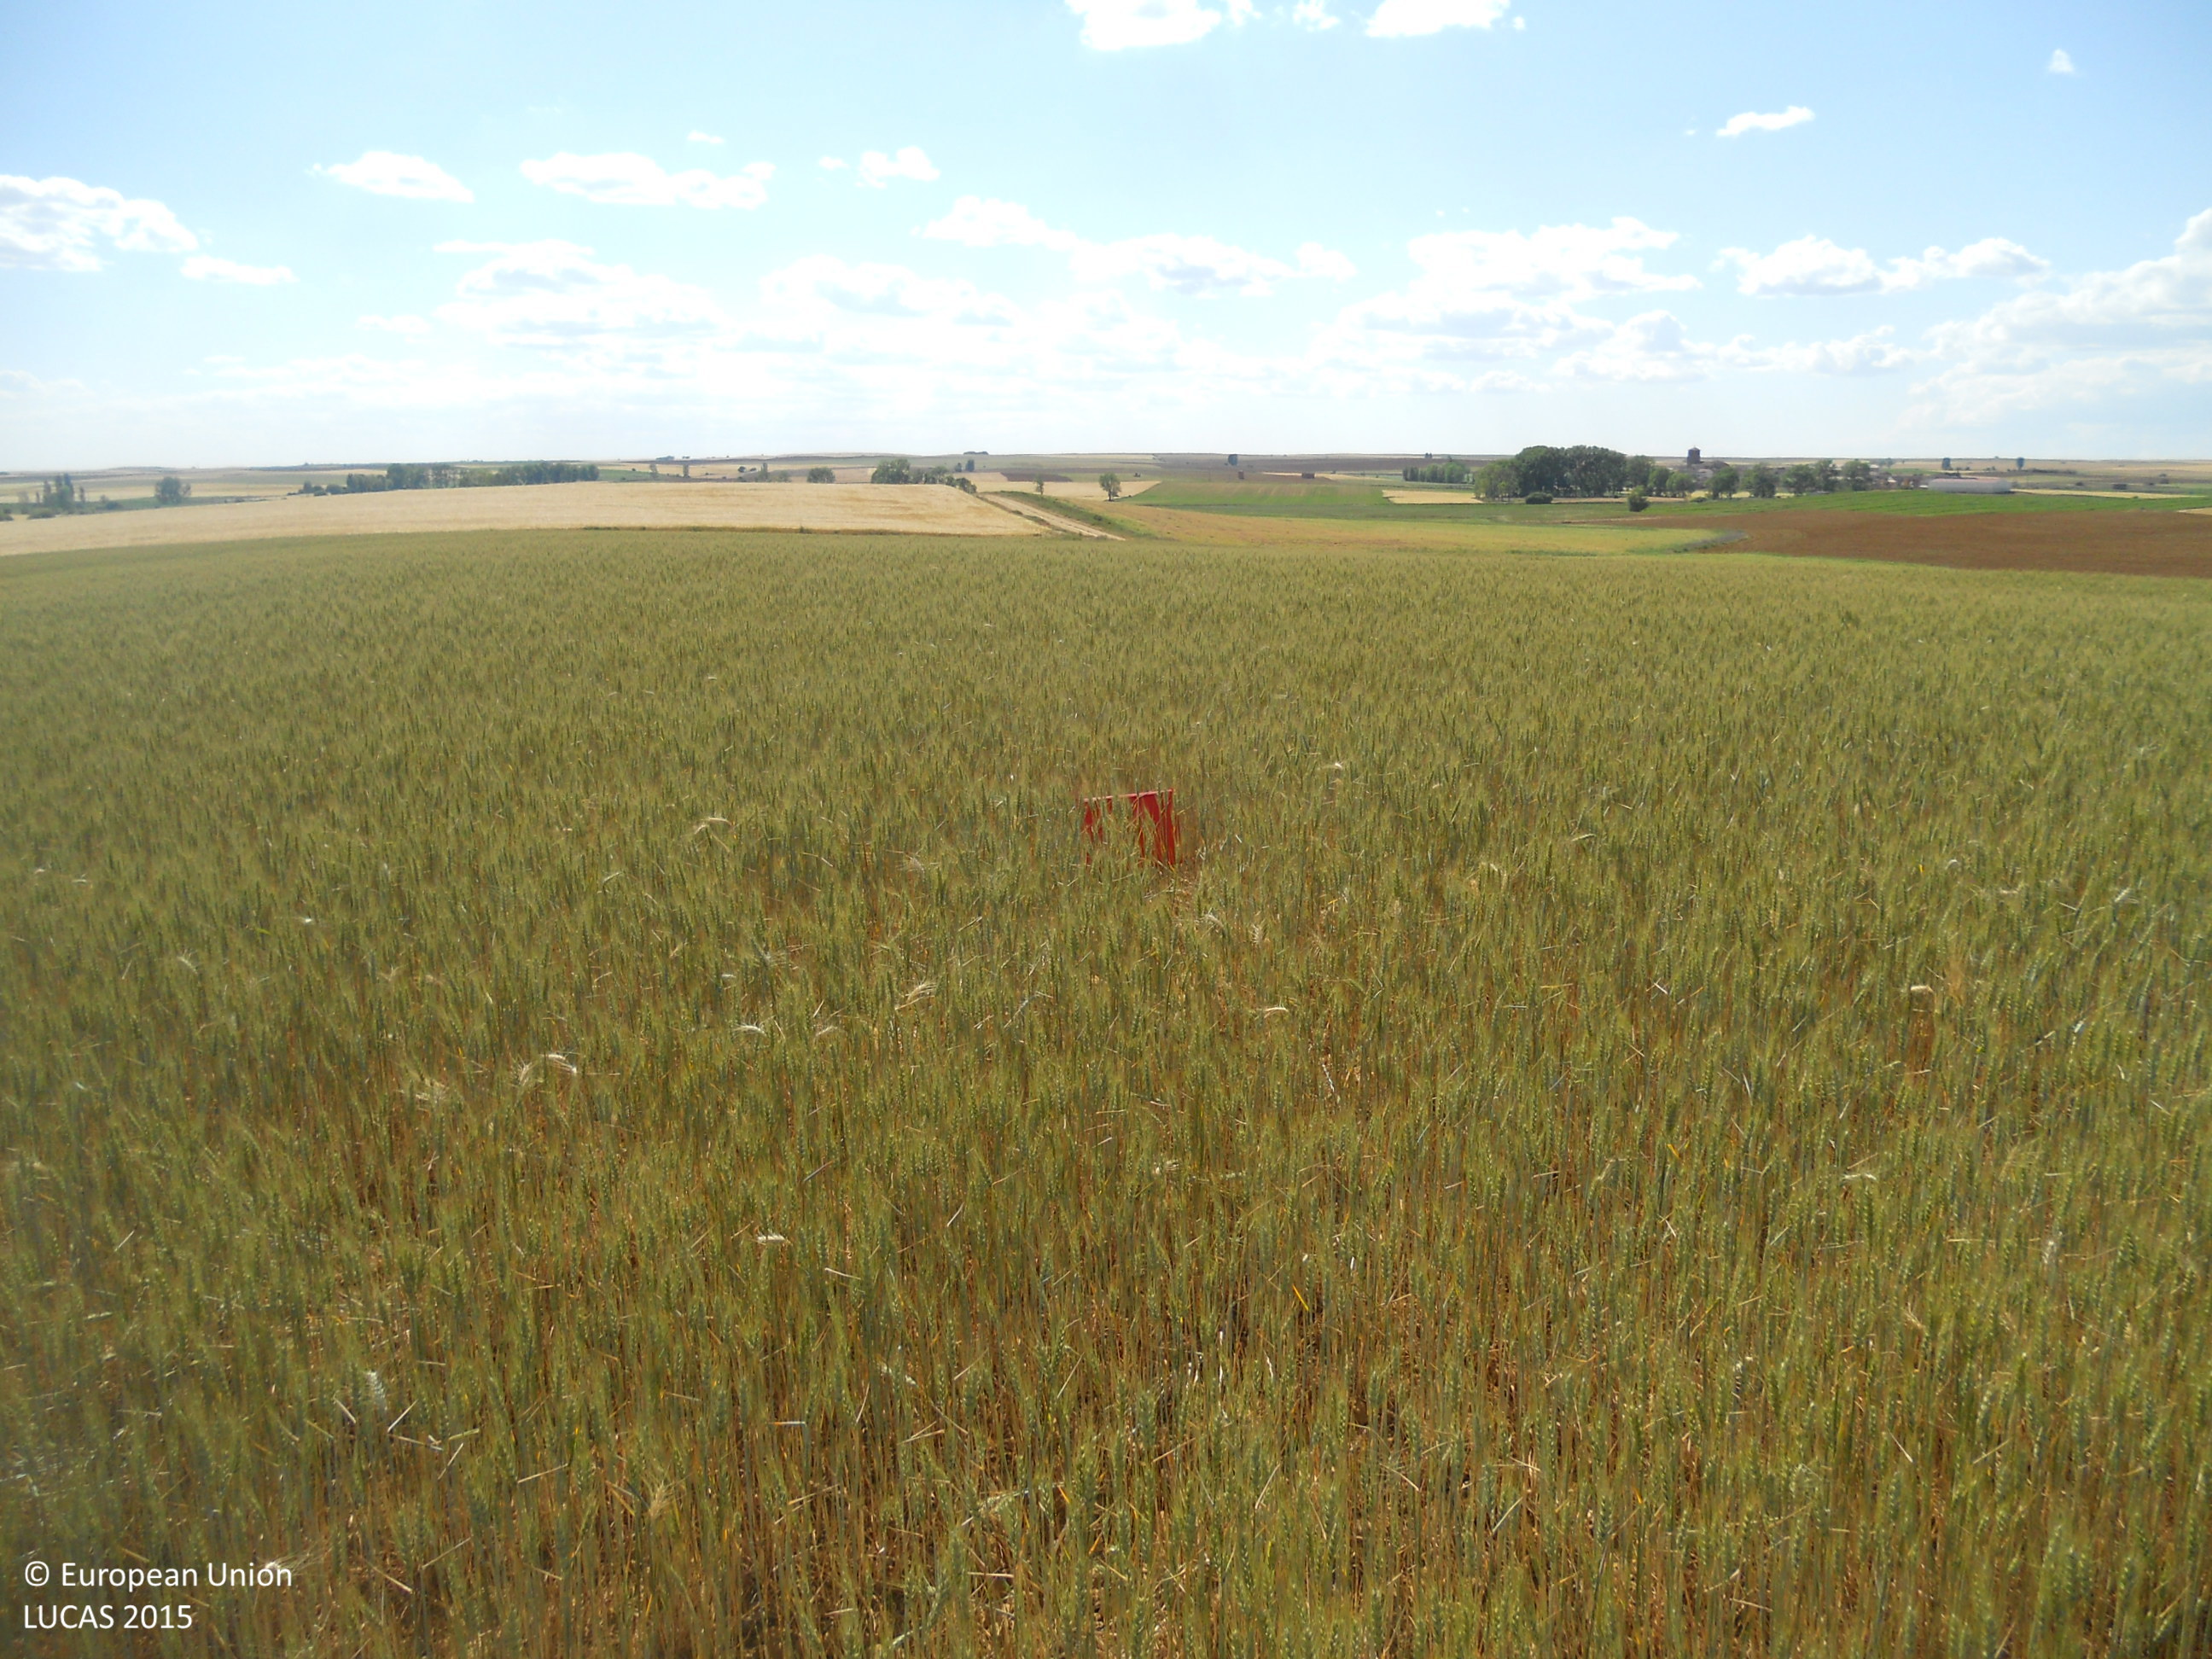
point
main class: Cropland
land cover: Durum wheat
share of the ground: > 75 %
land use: Agriculture (excluding fallow land and kitchen gardens)
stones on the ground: < 10 %
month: May
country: ES
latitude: 42.2874
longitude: -4.8382
